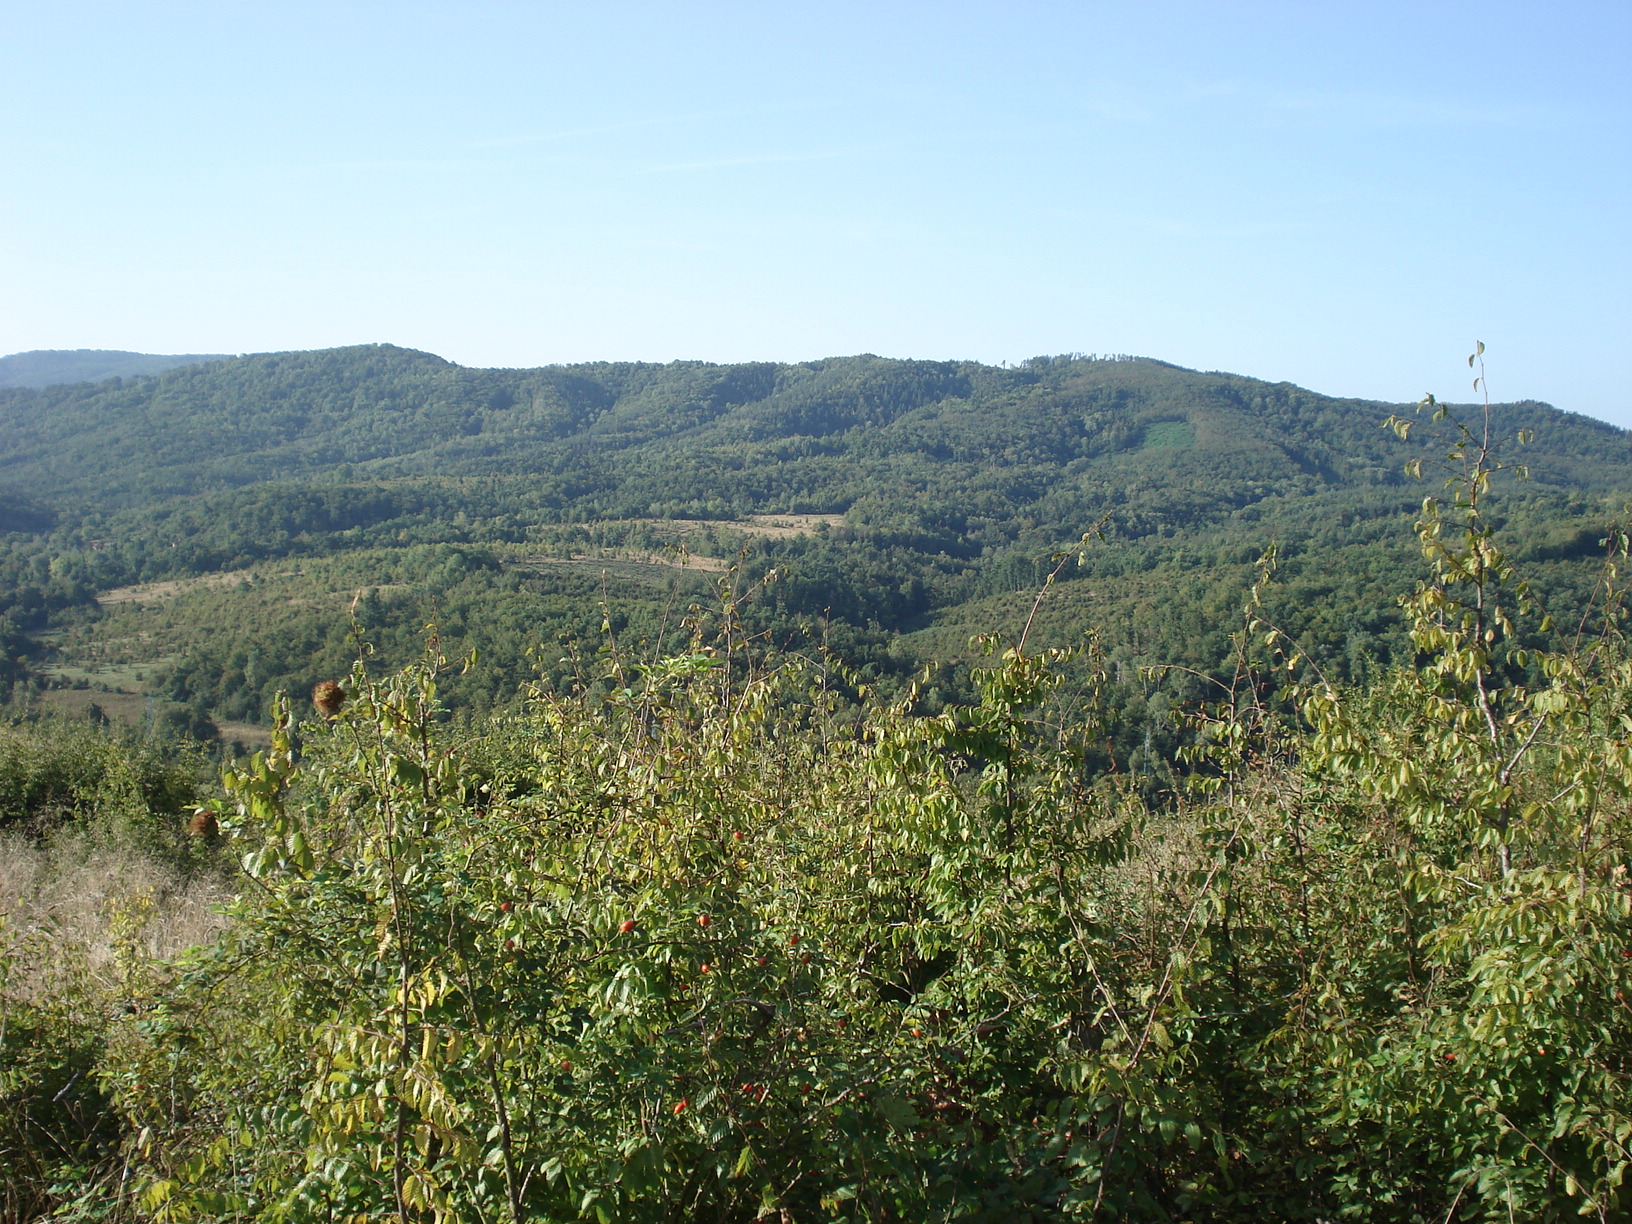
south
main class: Woodland
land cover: Pine dominated mixed woodland
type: hemiboreal forest and nemoral coniferous forest and mixed broadleaved-coniferous forest
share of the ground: 50 - 75 %
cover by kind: coniferous forest trees 35 %, broadleaved forest trees 35 %, shrubs 20 %, herbaceous plants 10 %
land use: Forestry
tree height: < 5 m
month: September
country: BG
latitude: 42.9224
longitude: 25.7248
